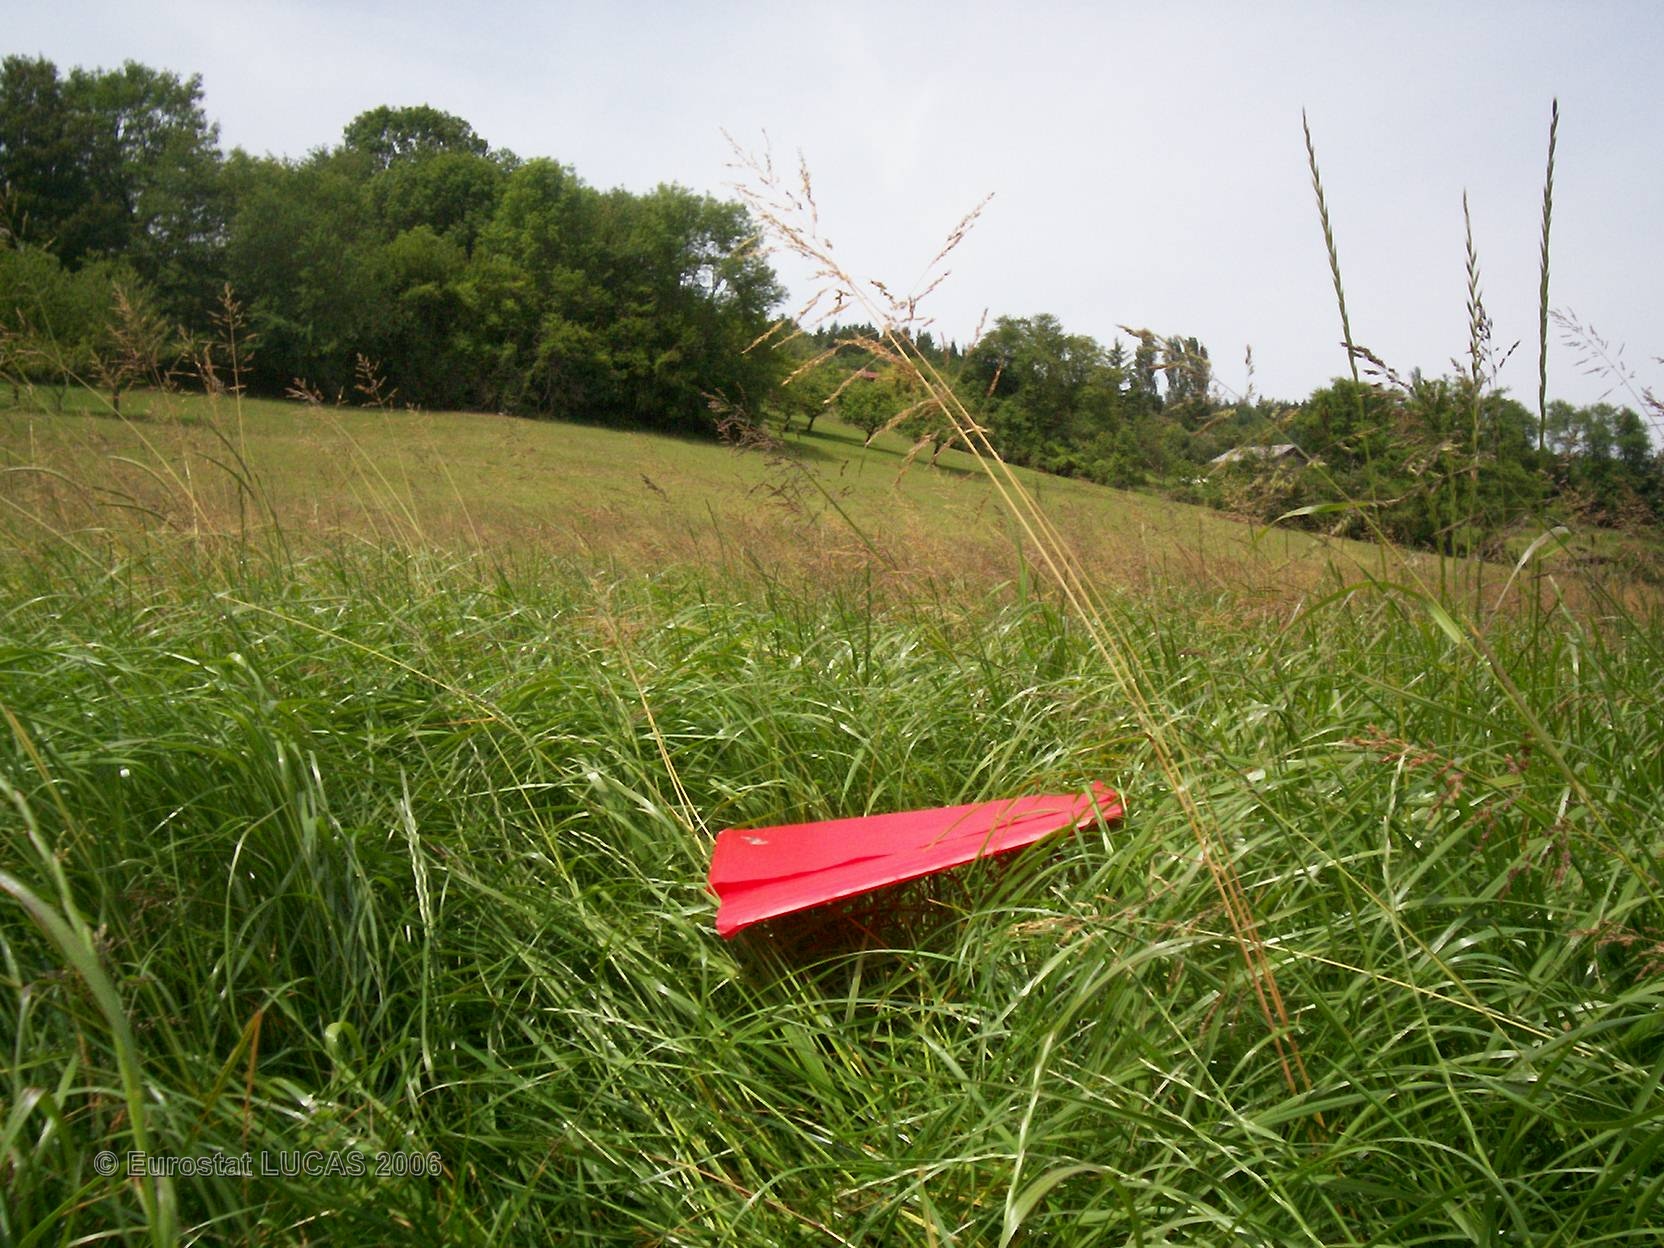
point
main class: Grassland
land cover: Grassland without tree/shrub cover
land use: Agriculture (excluding fallow land and kitchen gardens)
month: June
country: FR
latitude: 46.3080
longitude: 6.3806
